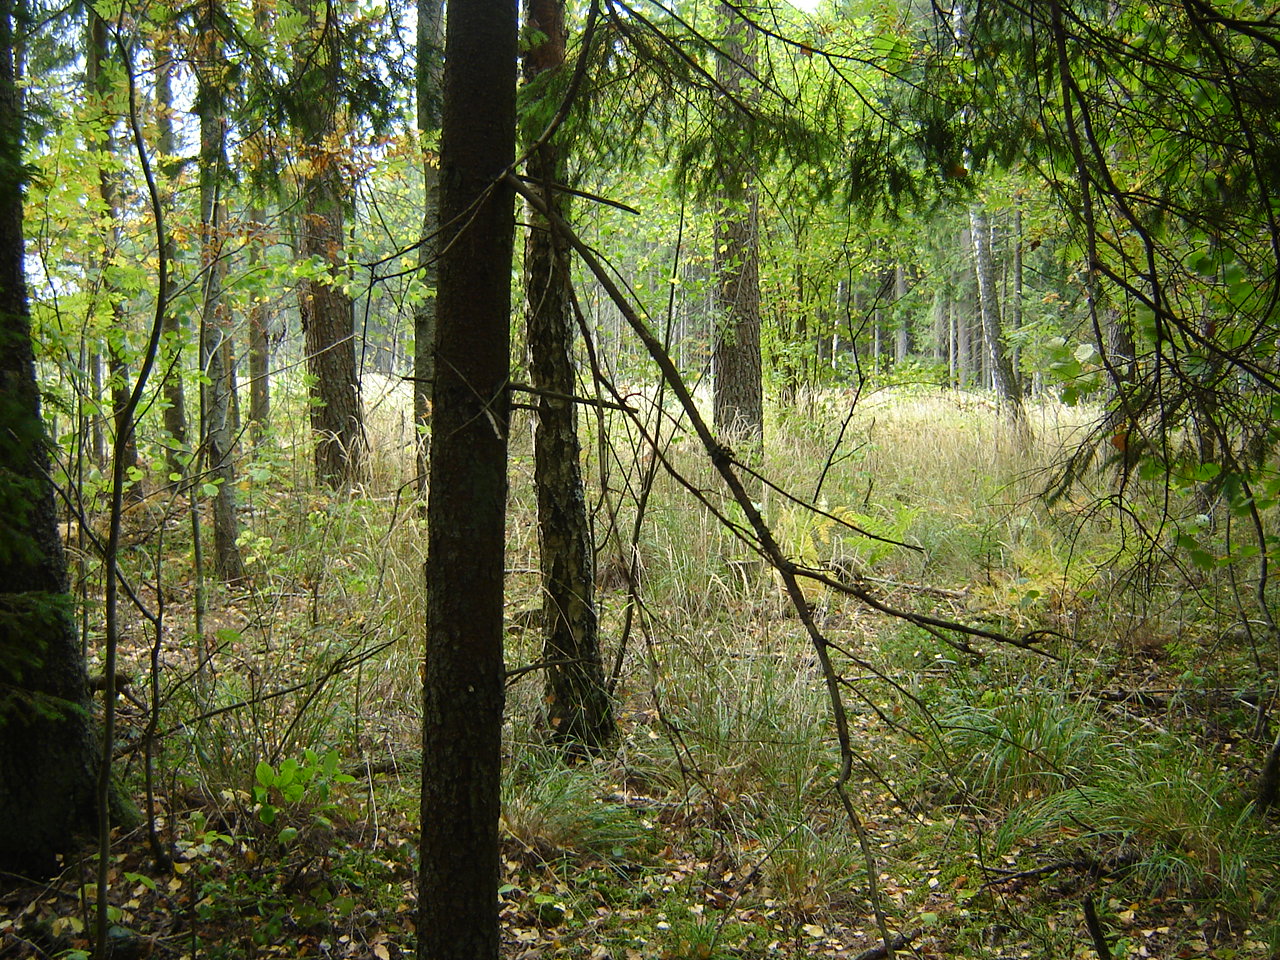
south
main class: Woodland
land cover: Pine dominated mixed woodland
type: hemiboreal forest and nemoral coniferous forest and mixed broadleaved-coniferous forest
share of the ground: > 75 %
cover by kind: coniferous forest trees 60 %, broadleaved forest trees 30 %, herbaceous plants 5 %, unconsolidated bare surface 5 %
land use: Forestry
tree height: > 5 m
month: September
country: LT
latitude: 54.4836
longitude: 25.0733
